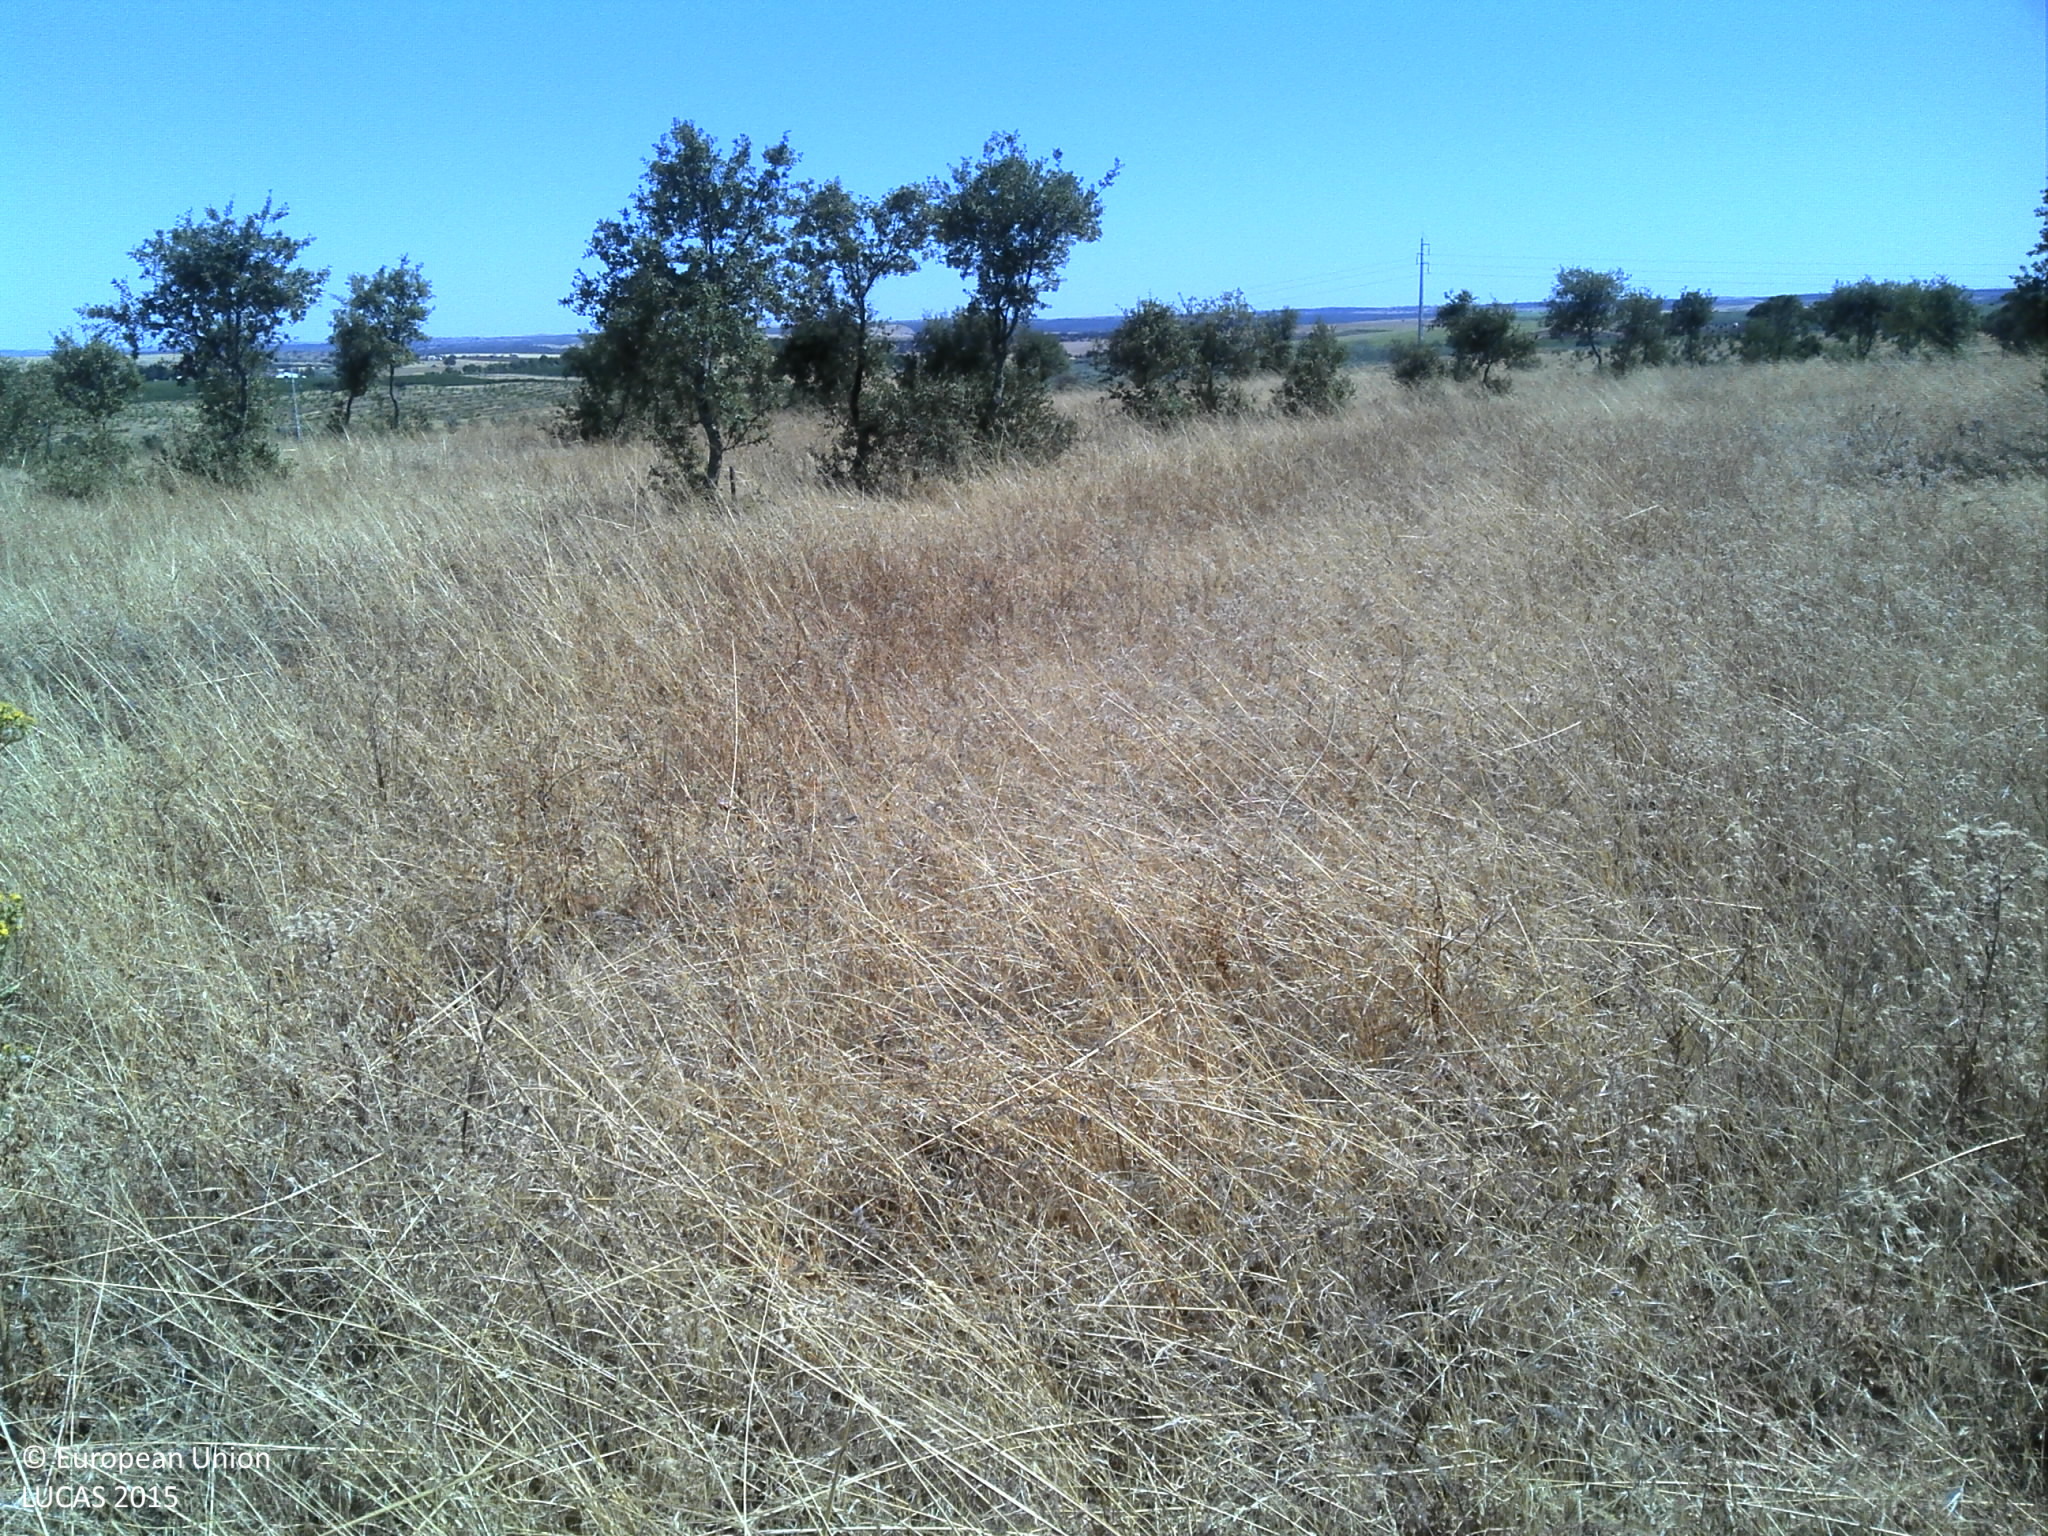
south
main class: Woodland
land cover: Broadleaved woodland
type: broadleaved evergreen forest
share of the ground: 25 - 50 %
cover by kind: broadleaved forest trees 40 %, unconsolidated bare surface 30 %, herbaceous plants 25 %, shrubs 5 %
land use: Forestry
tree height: < 5 m
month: July
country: PT
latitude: 38.1753
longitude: -7.7328
